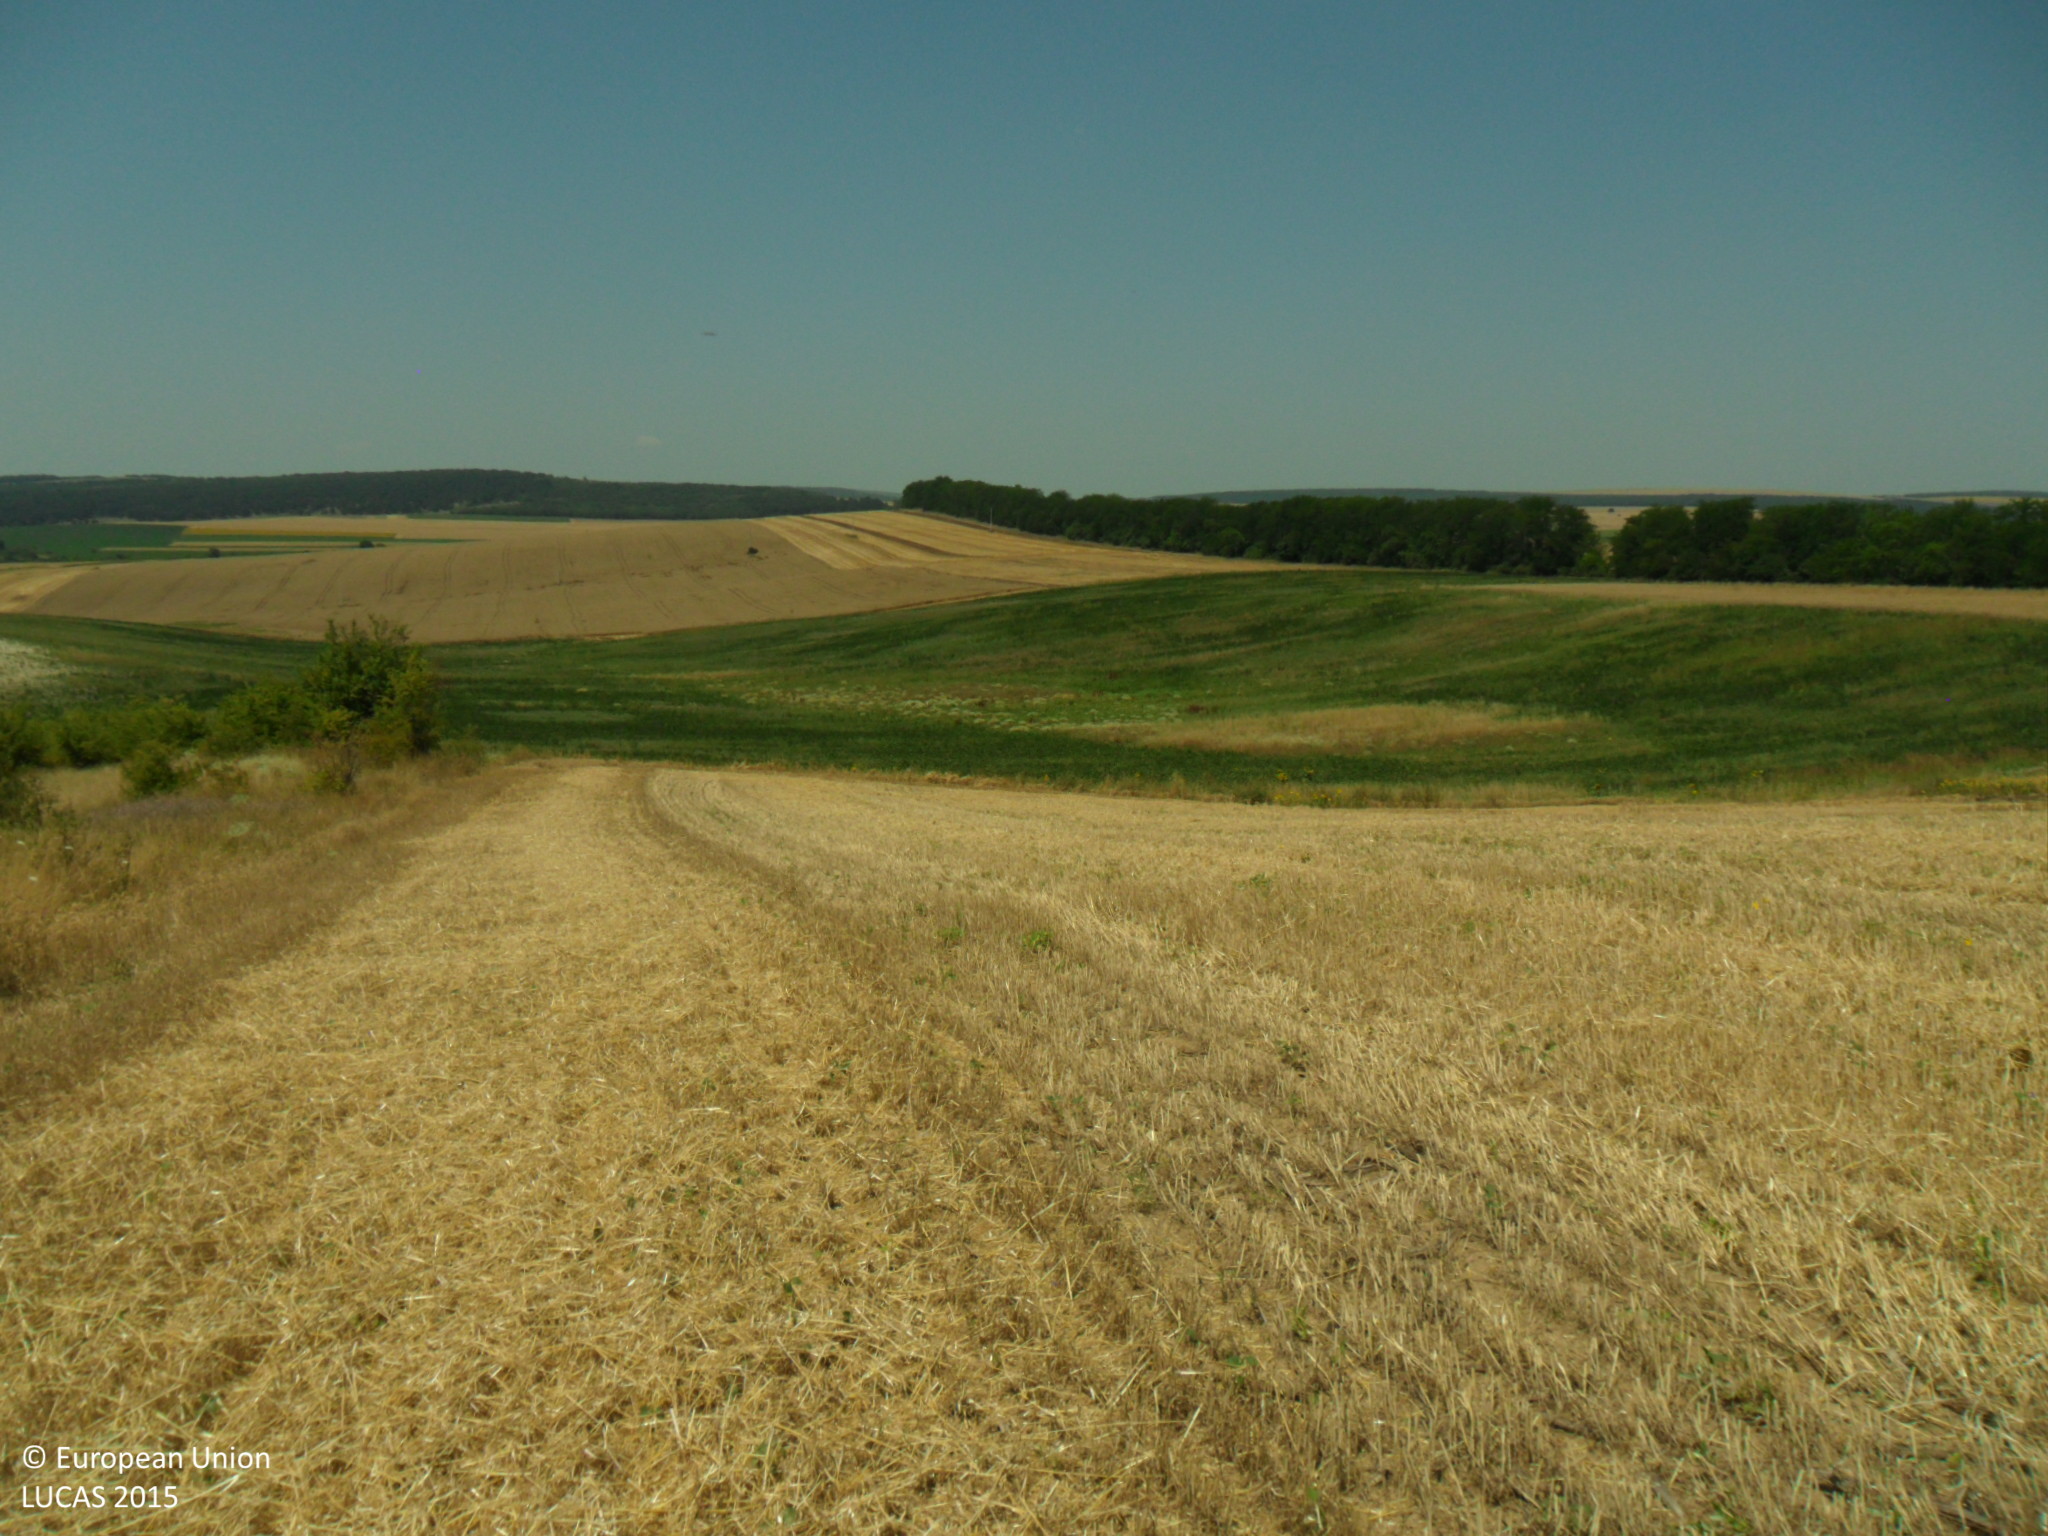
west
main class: Cropland
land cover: Common wheat
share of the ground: 50 - 75 %
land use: Agriculture (excluding fallow land and kitchen gardens)
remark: Harvested field
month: July
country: BG
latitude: 43.4001
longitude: 26.6397
